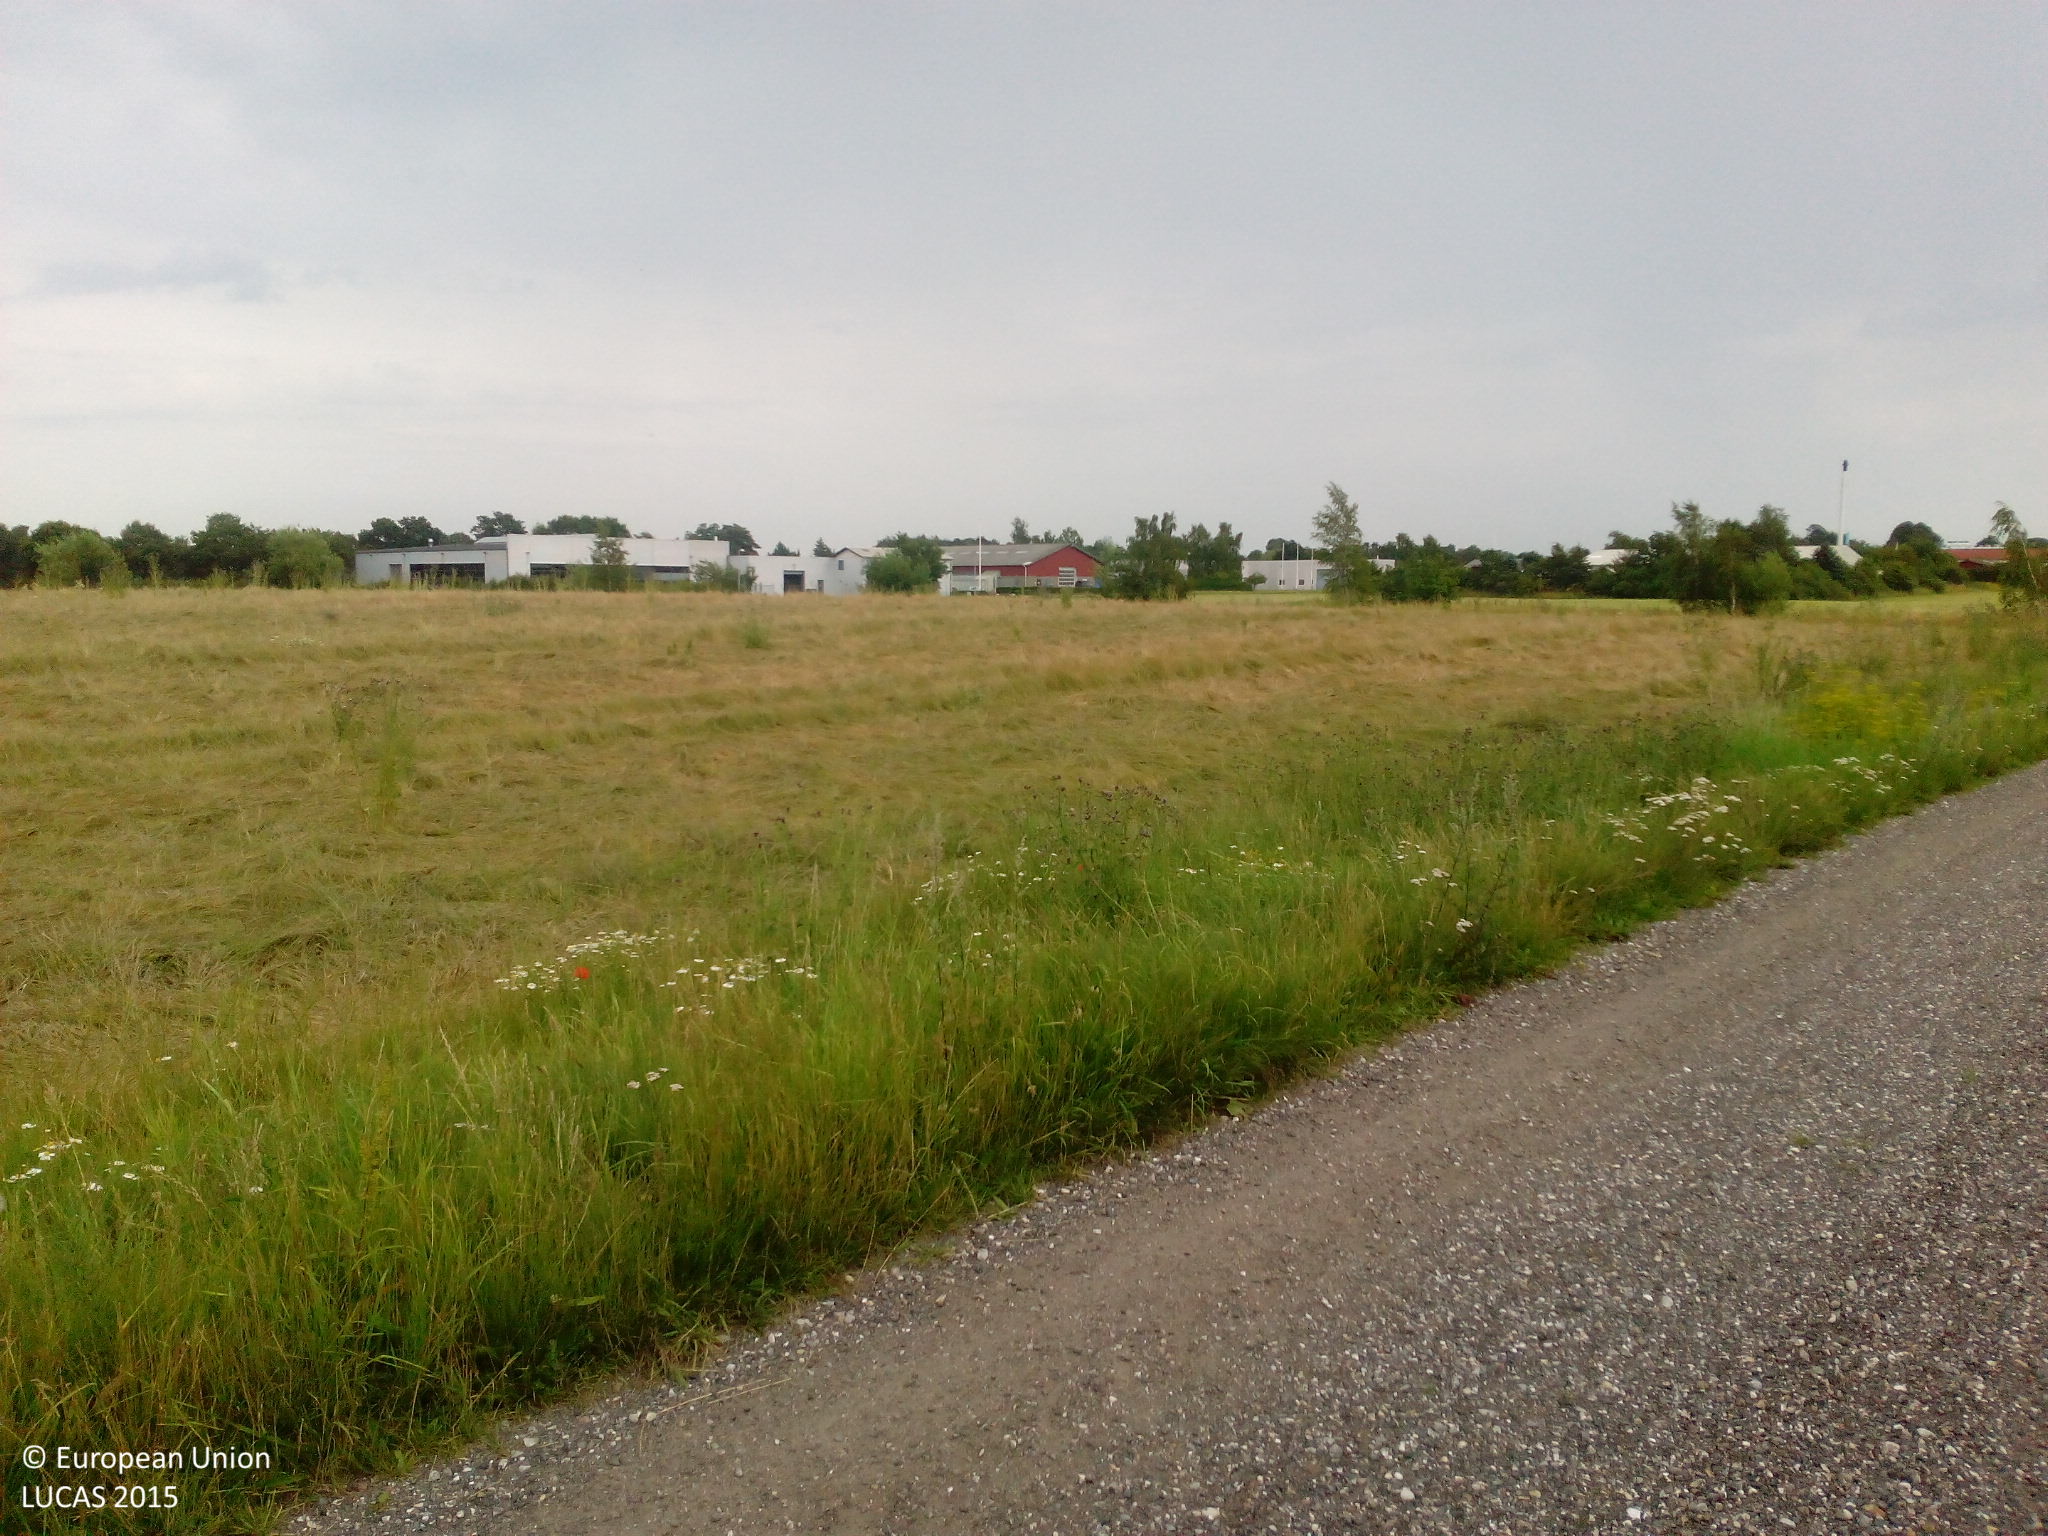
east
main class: Cropland
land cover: Temporary grasslands
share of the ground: > 75 %
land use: Agriculture (excluding fallow land and kitchen gardens)
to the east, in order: Grass margins; Tracks; Grass margins; Temporary grasslands; Shruby margins; Single bushes/trees; Rivers and streams; Grassland without tree/shrub cover; Tracks; Grassland without tree/shrub cover; Paved roads, cycling and walking lanes
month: August
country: DK
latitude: 55.5616
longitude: 11.9486
